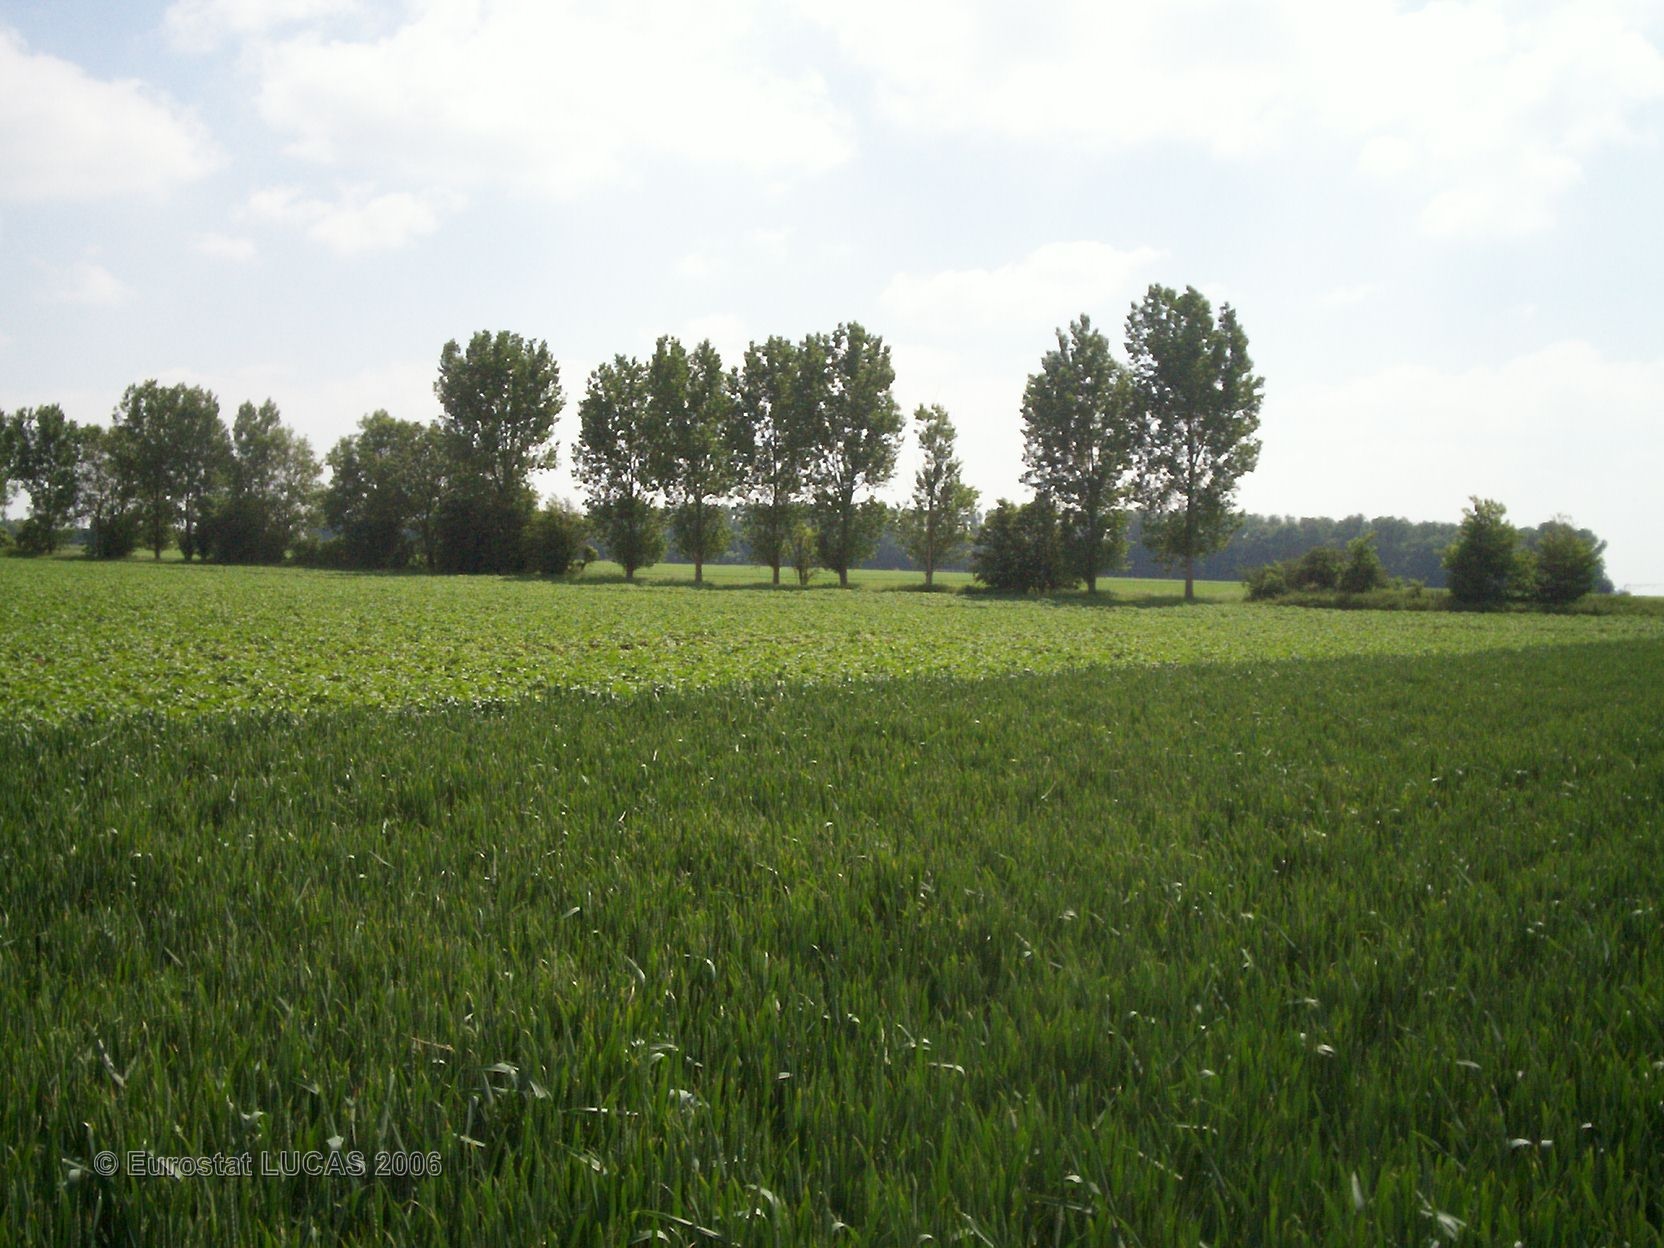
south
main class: Cropland
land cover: Common wheat
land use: Agriculture (excluding fallow land and kitchen gardens)
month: June
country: FR
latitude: 49.7856
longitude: 2.6690
